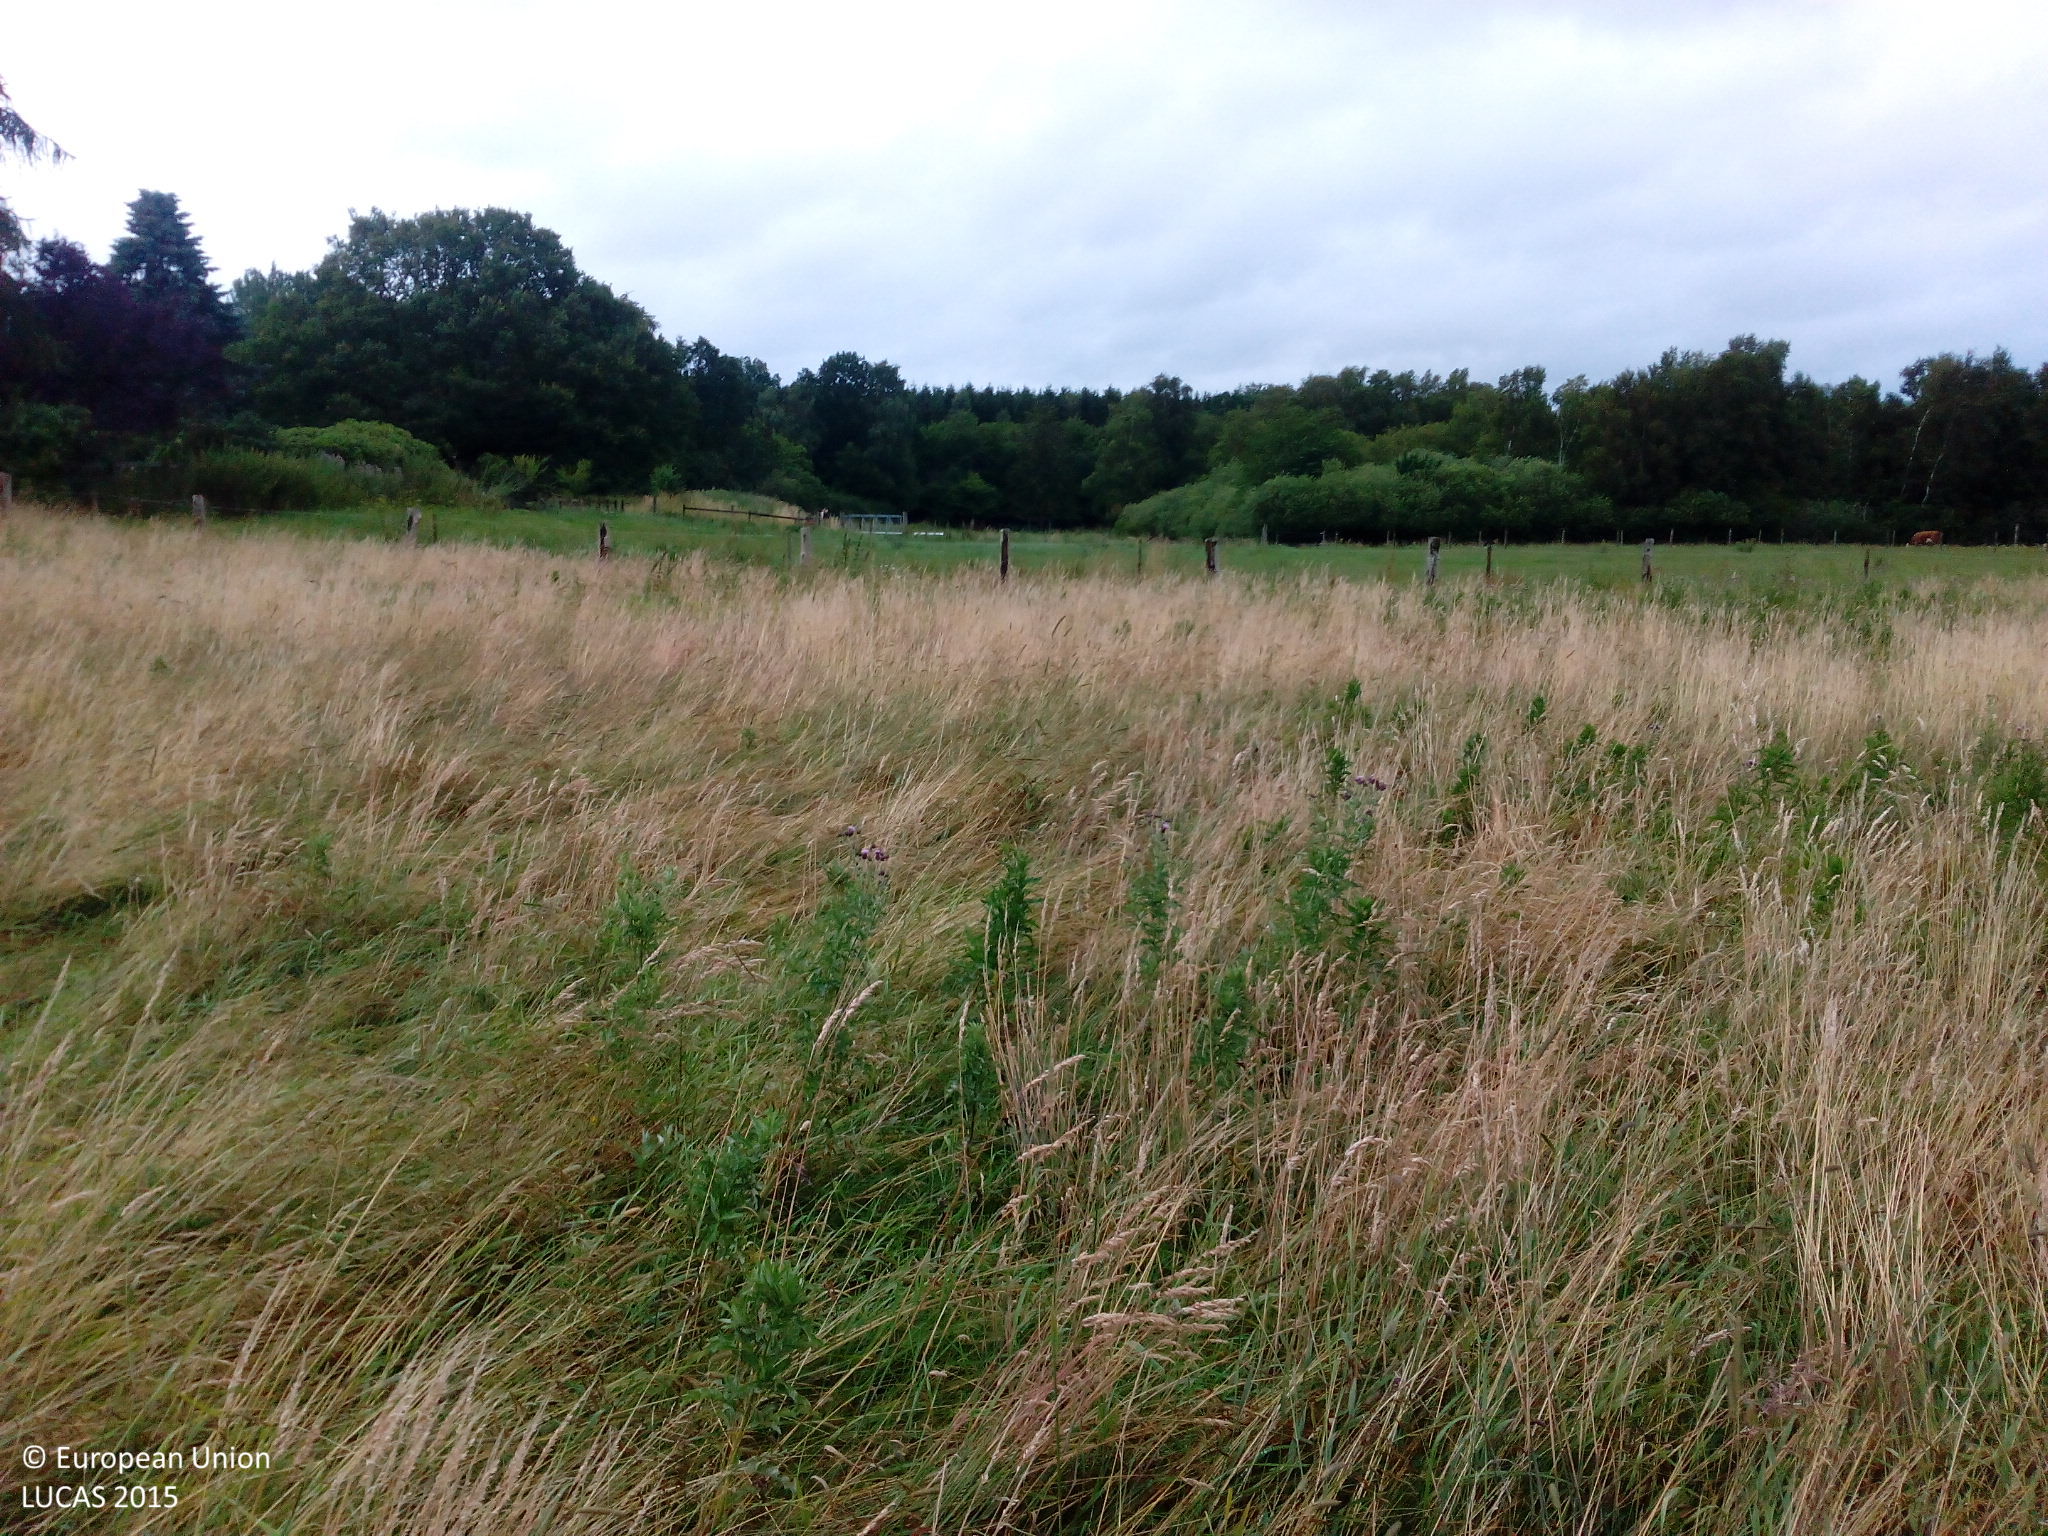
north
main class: Grassland
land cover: Grassland without tree/shrub cover
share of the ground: > 75 %
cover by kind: herbaceous plants 100 %
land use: Agriculture (excluding fallow land and kitchen gardens)
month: July
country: DK
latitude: 55.8792
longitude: 12.3157
